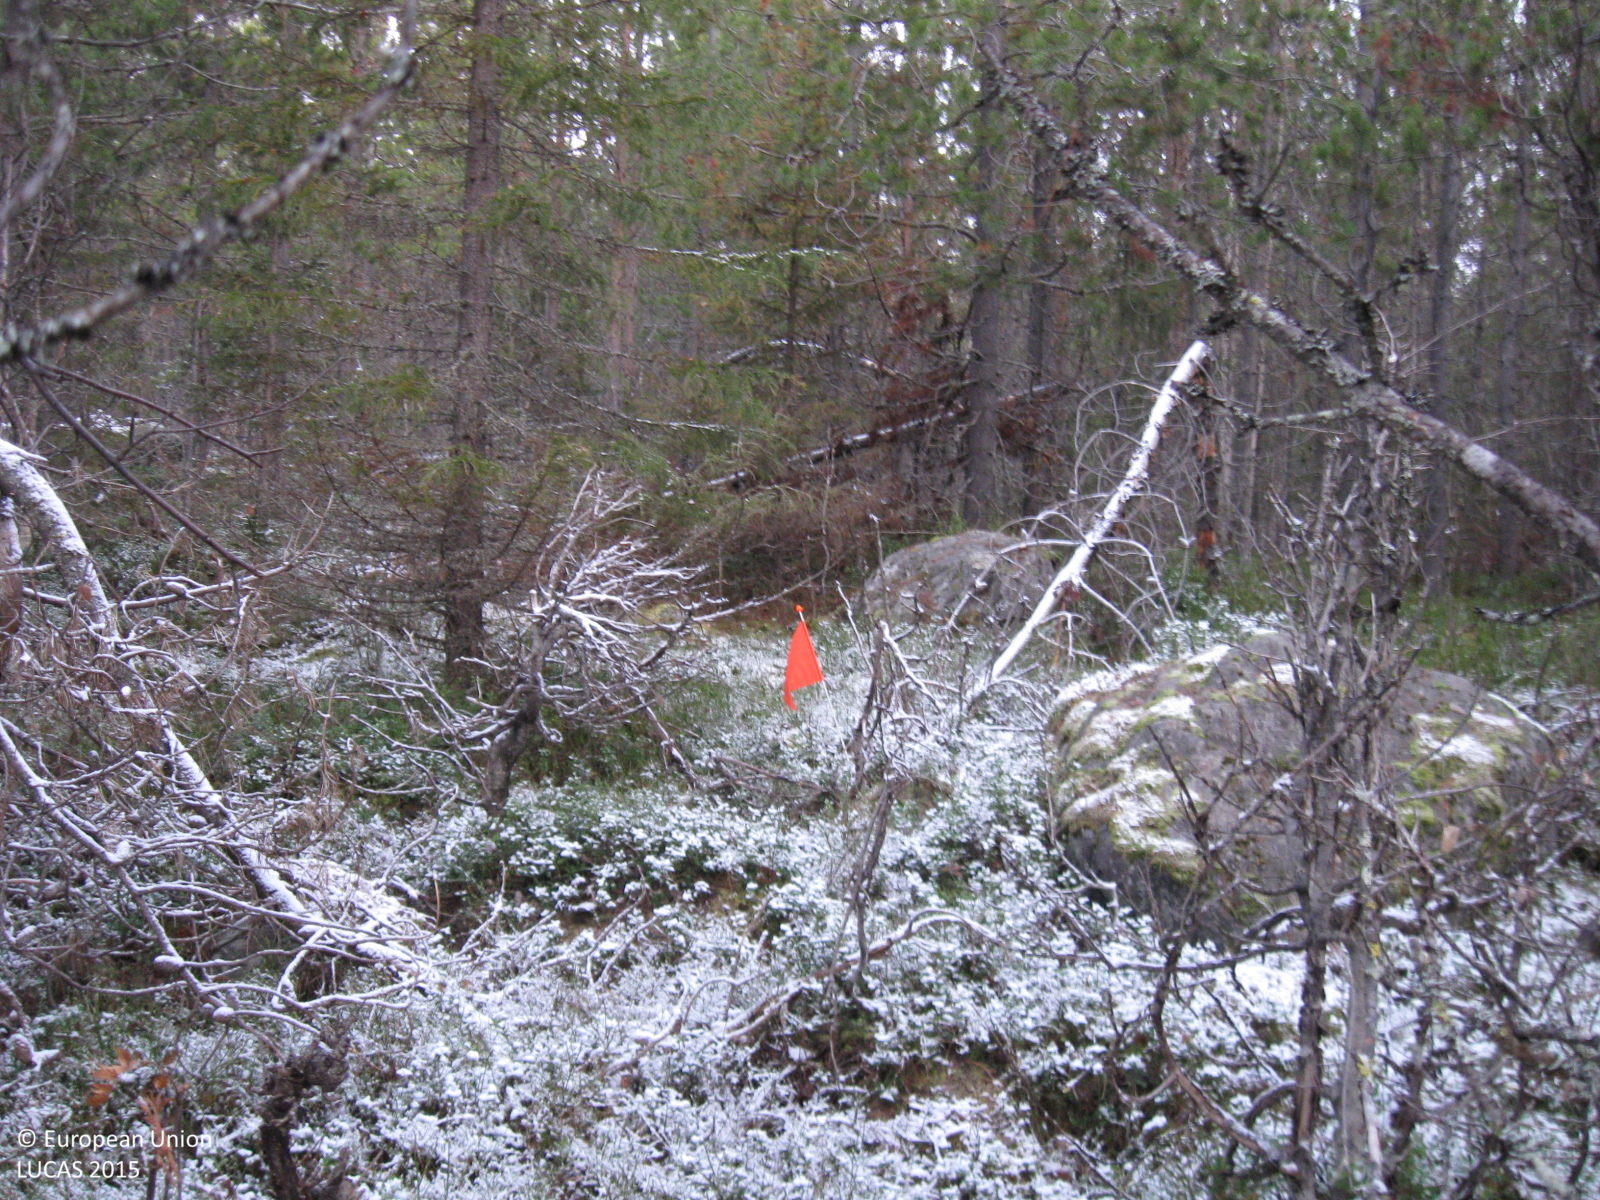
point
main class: Woodland
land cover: Pine dominated coniferous woodland
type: exotic forest
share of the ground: > 75 %
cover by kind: coniferous forest trees 80 %, broadleaved forest trees 5 %, shrubs 5 %, lichens and mosses 5 %, unconsolidated bare surface 5 %
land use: Forestry
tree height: > 5 m
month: October
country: SE
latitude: 66.2005
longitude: 21.6710
